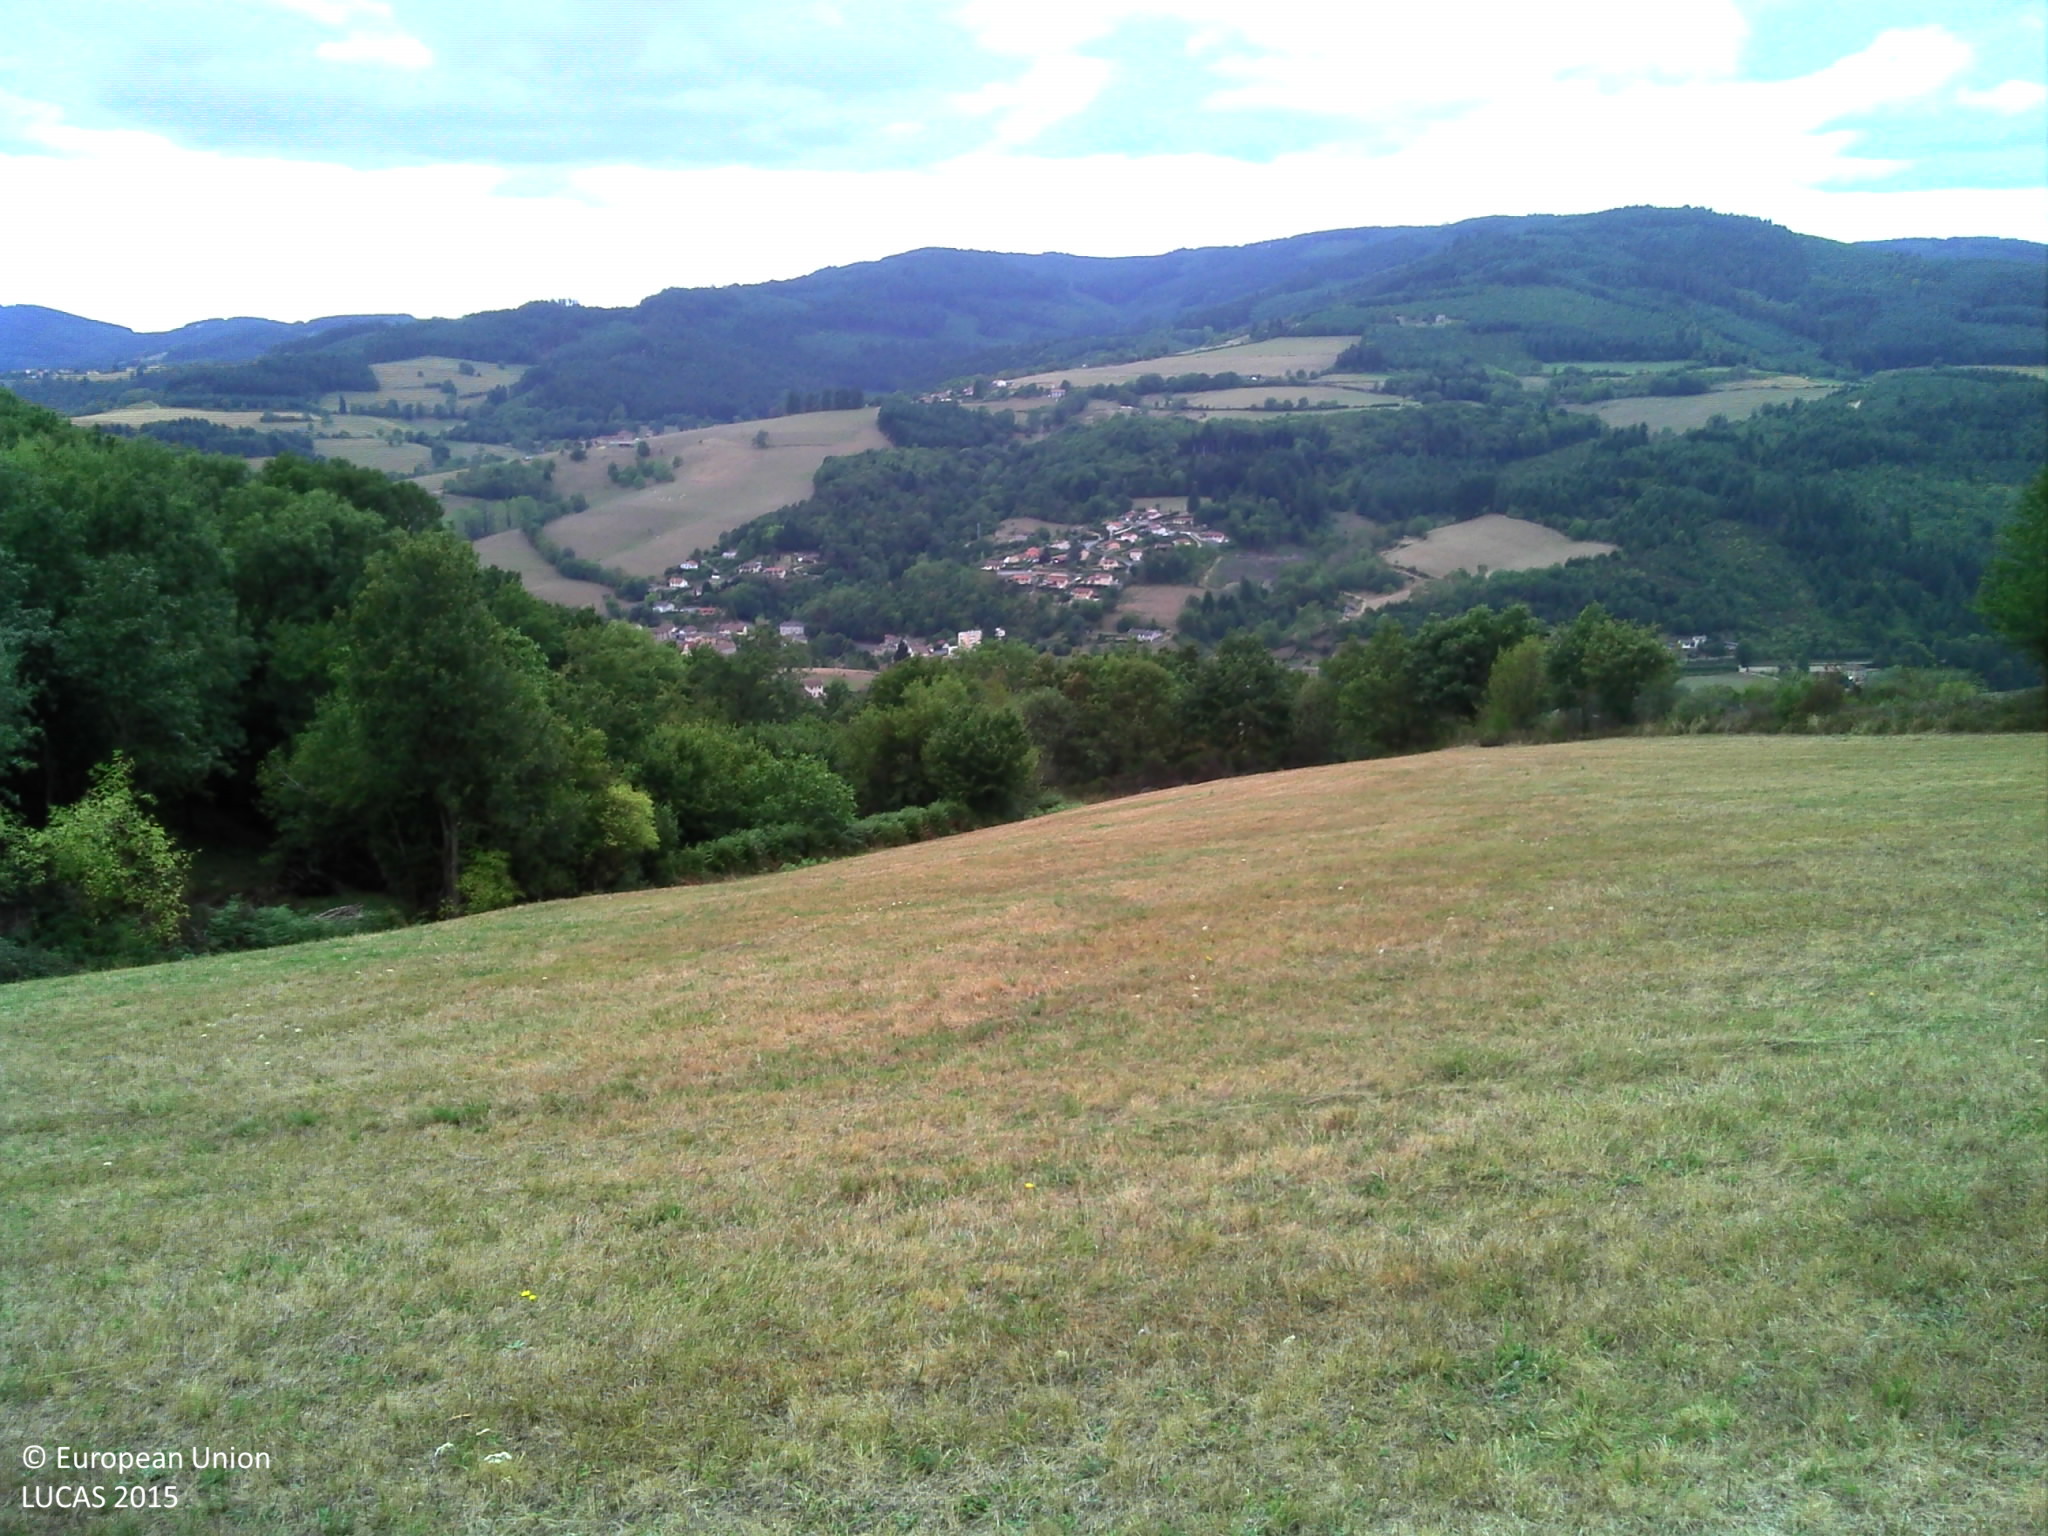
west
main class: Grassland
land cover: Grassland without tree/shrub cover
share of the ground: > 75 %
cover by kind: herbaceous plants 100 %
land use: Agriculture (excluding fallow land and kitchen gardens)
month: August
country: FR
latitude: 46.0657
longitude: 4.5081
